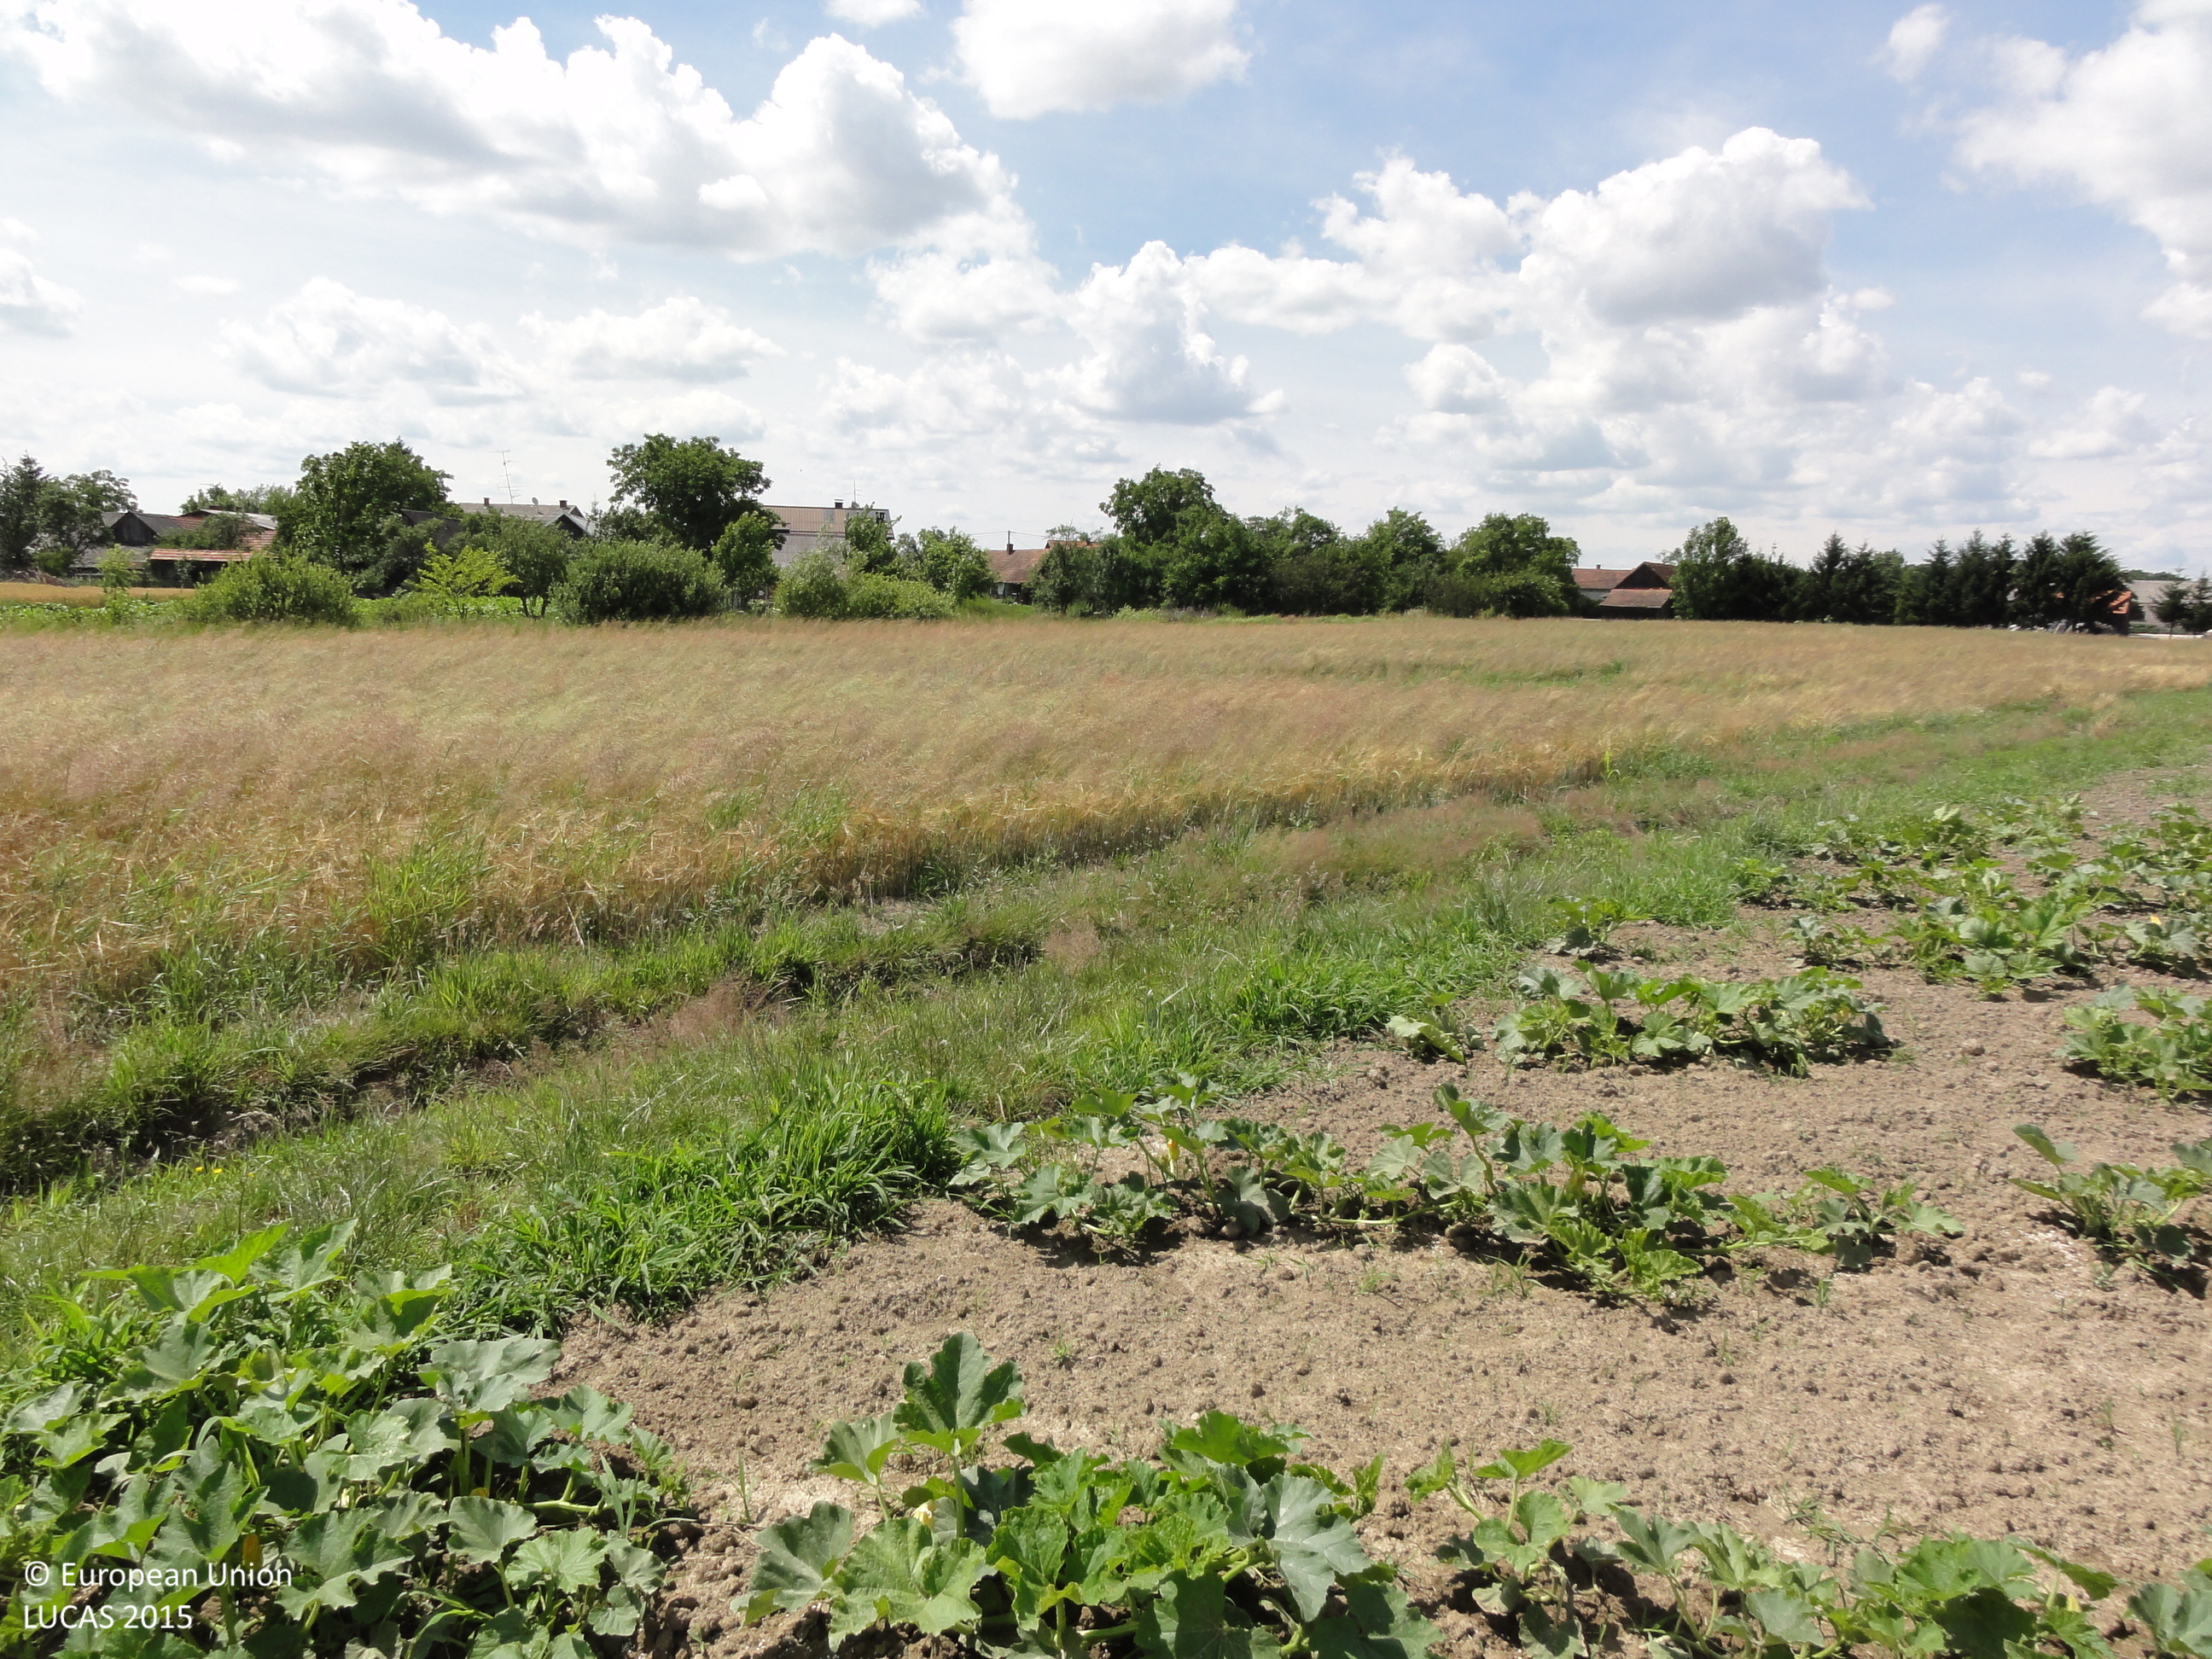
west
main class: Cropland
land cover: Other fibre and oleaginous crops
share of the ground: 25 - 50 %
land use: Agriculture (excluding fallow land and kitchen gardens)
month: June
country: SI
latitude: 46.6120
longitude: 16.3860
